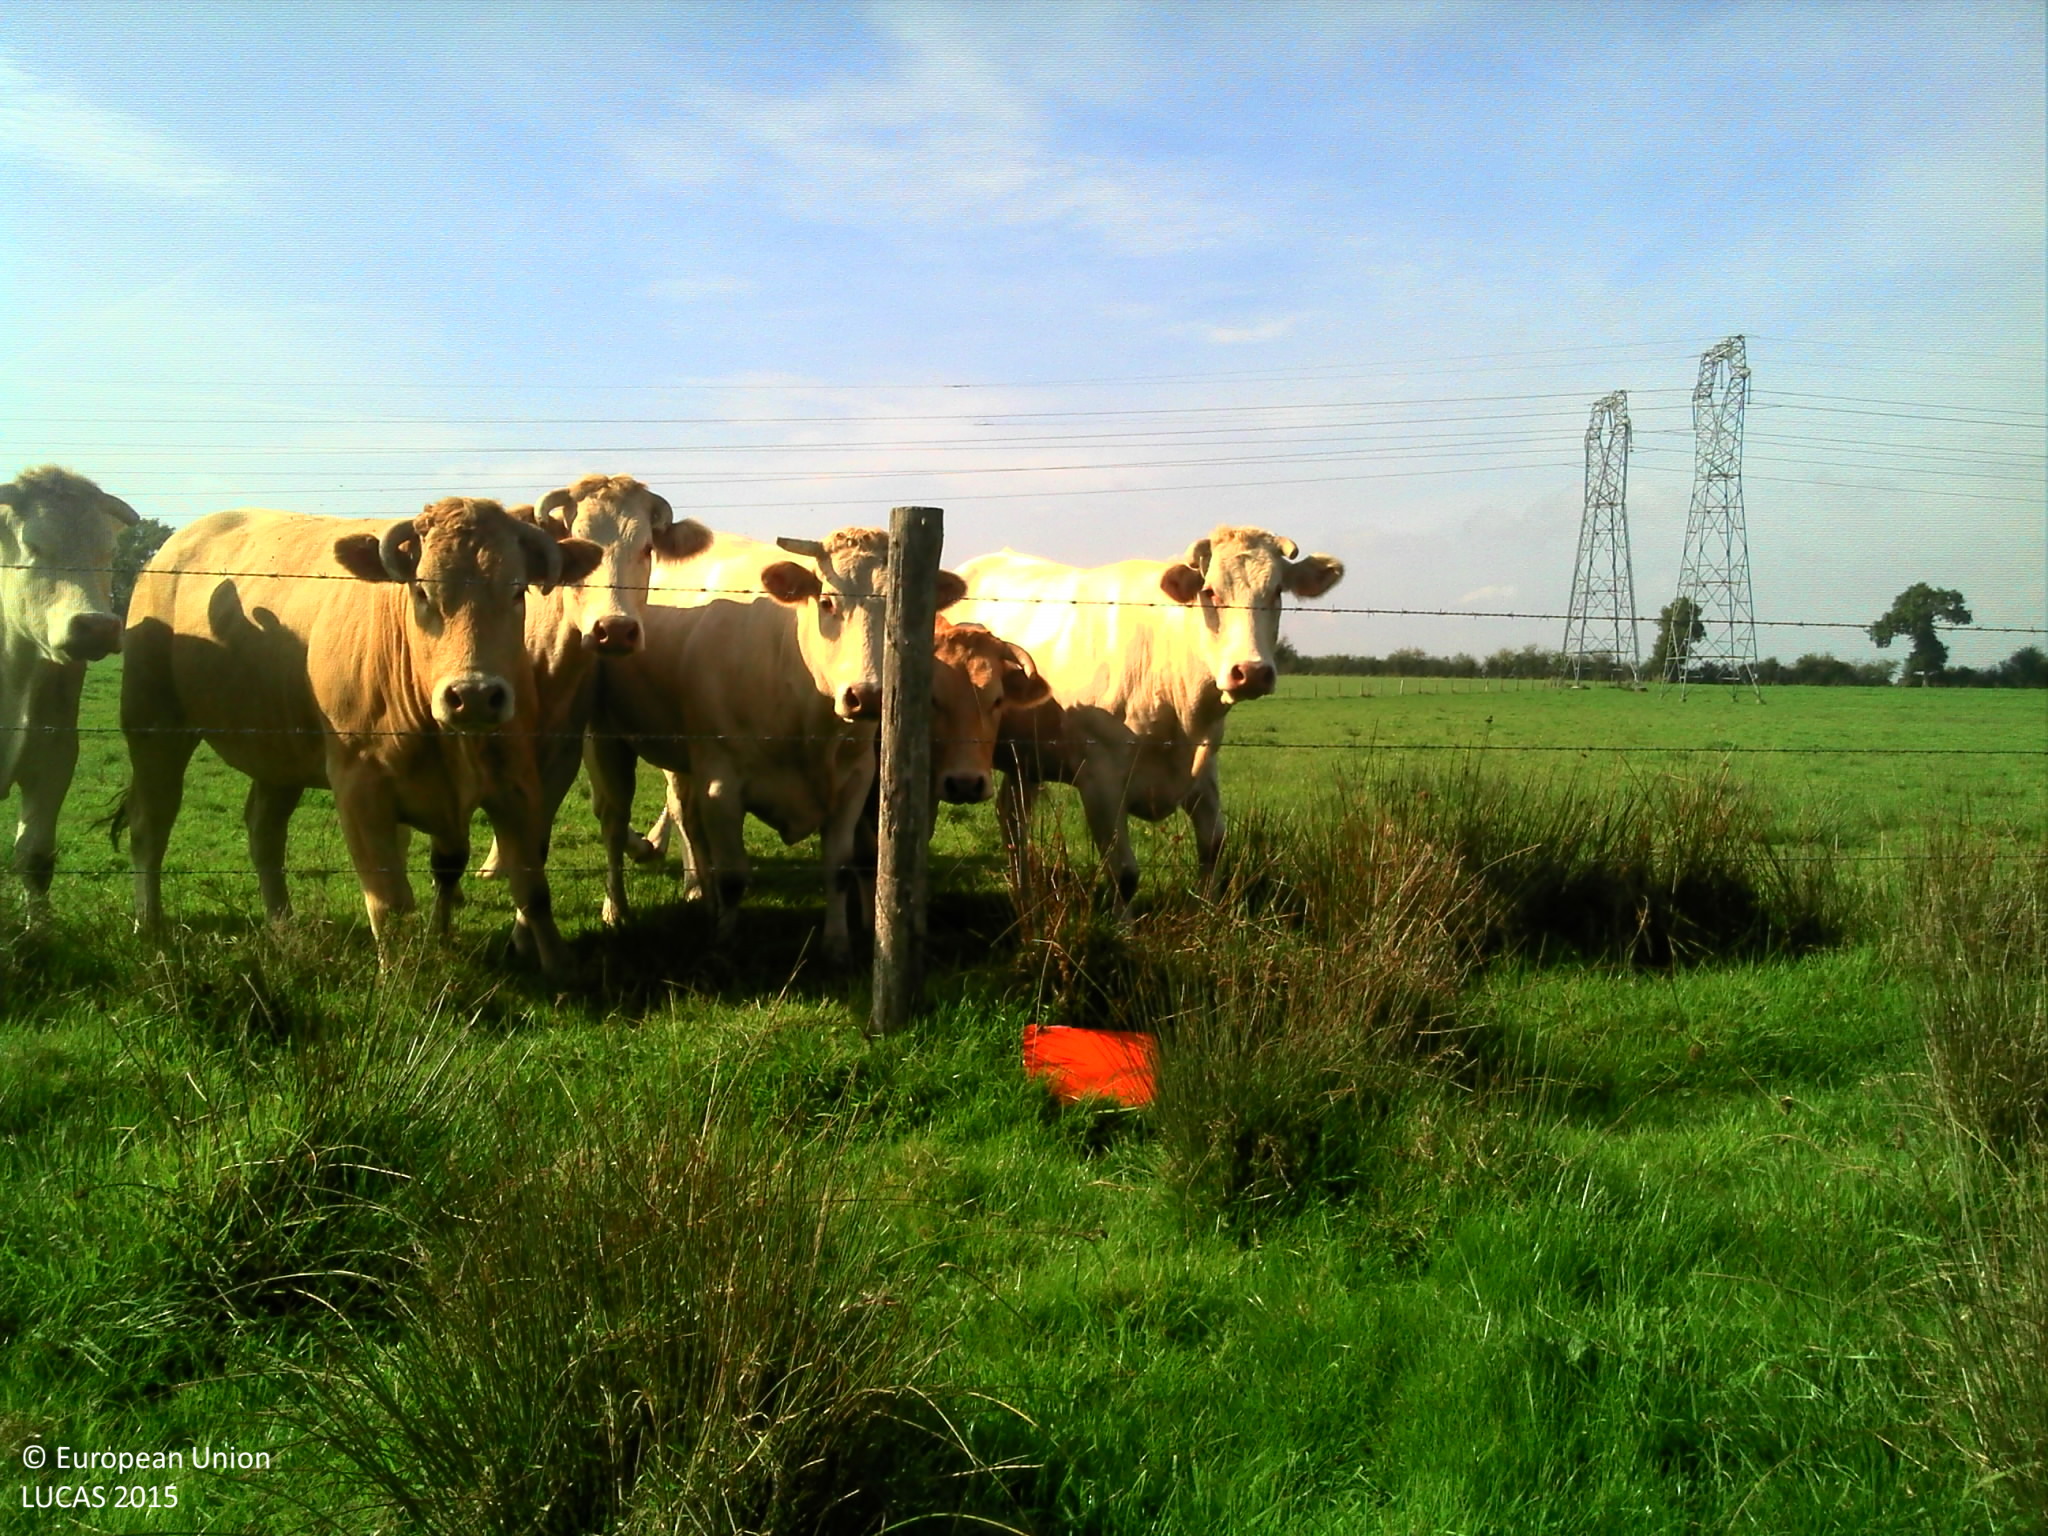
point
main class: Grassland
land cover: Grassland without tree/shrub cover
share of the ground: > 75 %
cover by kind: herbaceous plants 100 %
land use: Agriculture (excluding fallow land and kitchen gardens)
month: October
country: FR
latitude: 47.0973
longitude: -0.9297
